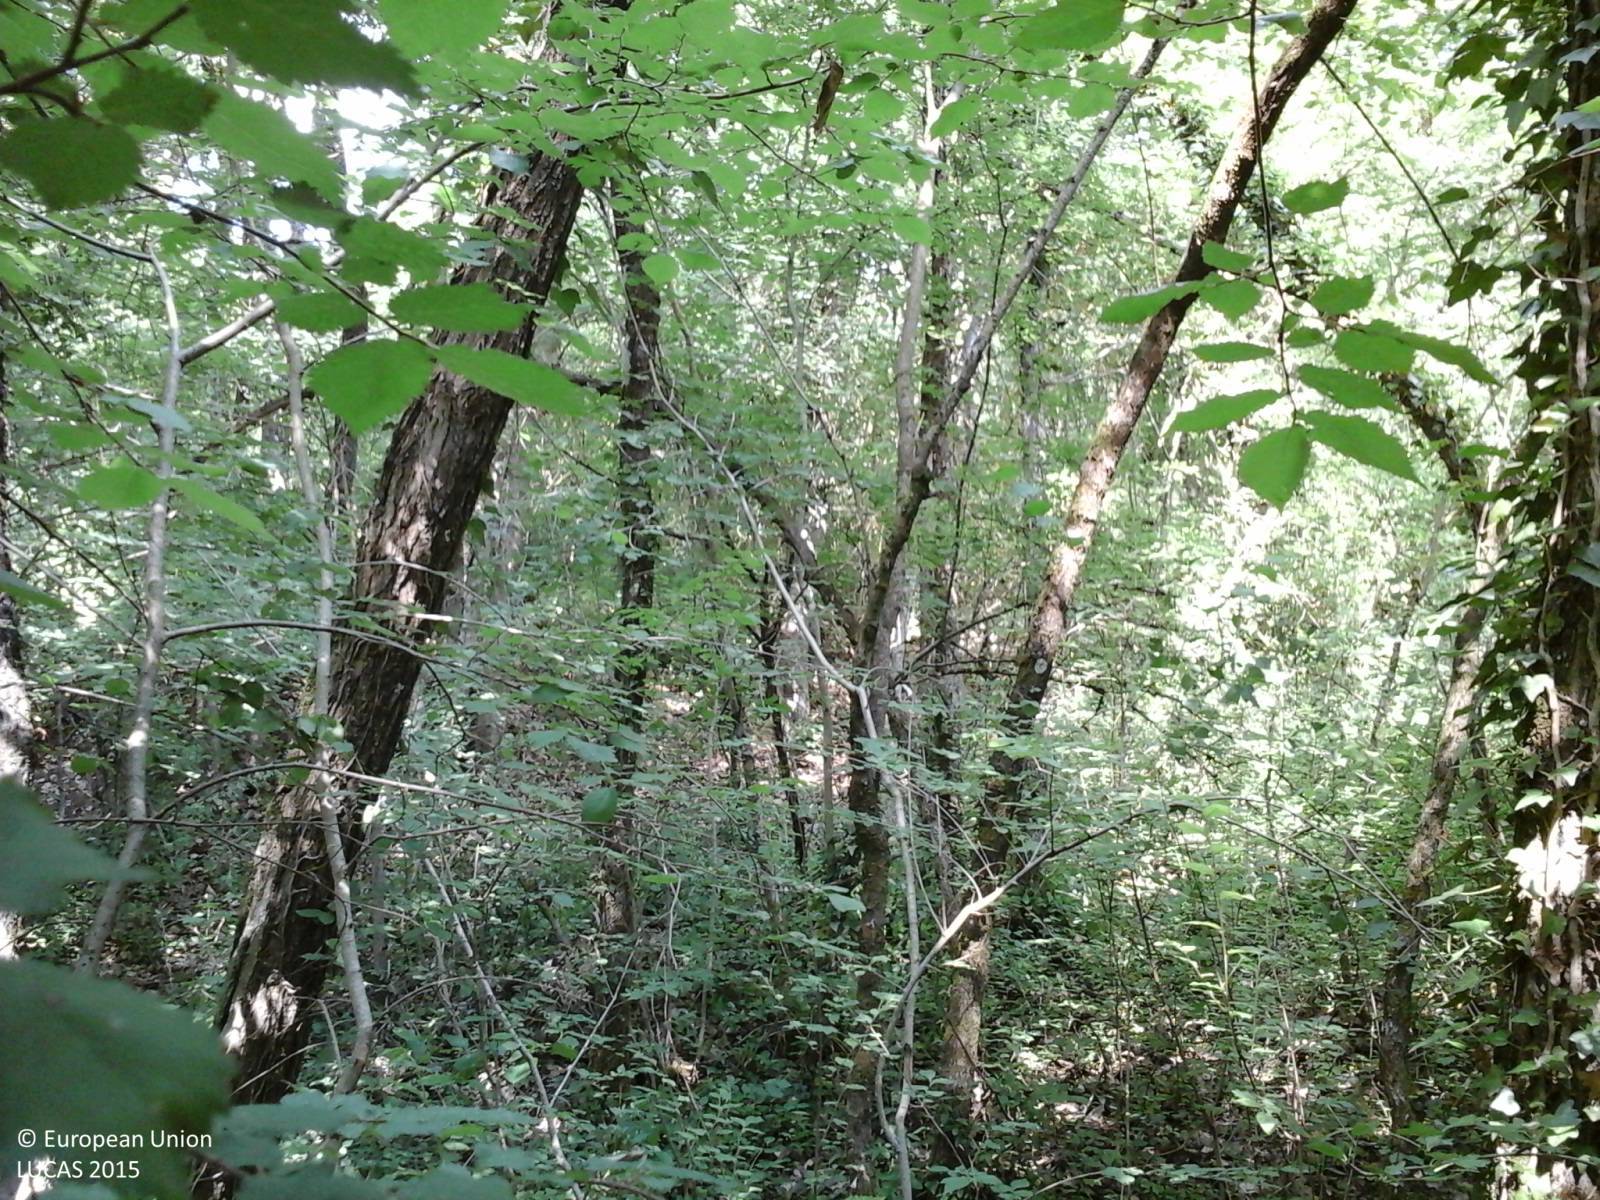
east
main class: Woodland
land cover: Broadleaved woodland
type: thermophilous deciduous forest
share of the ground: > 75 %
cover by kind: broadleaved forest trees 100 %
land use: Forestry
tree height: > 5 m
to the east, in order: Broadleaved woodland; Dry stone walls; Broadleaved woodland; Grassland with sparse tree/shrub cover; Grassland without tree/shrub cover
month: June
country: IT
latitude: 42.0371
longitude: 13.3827
